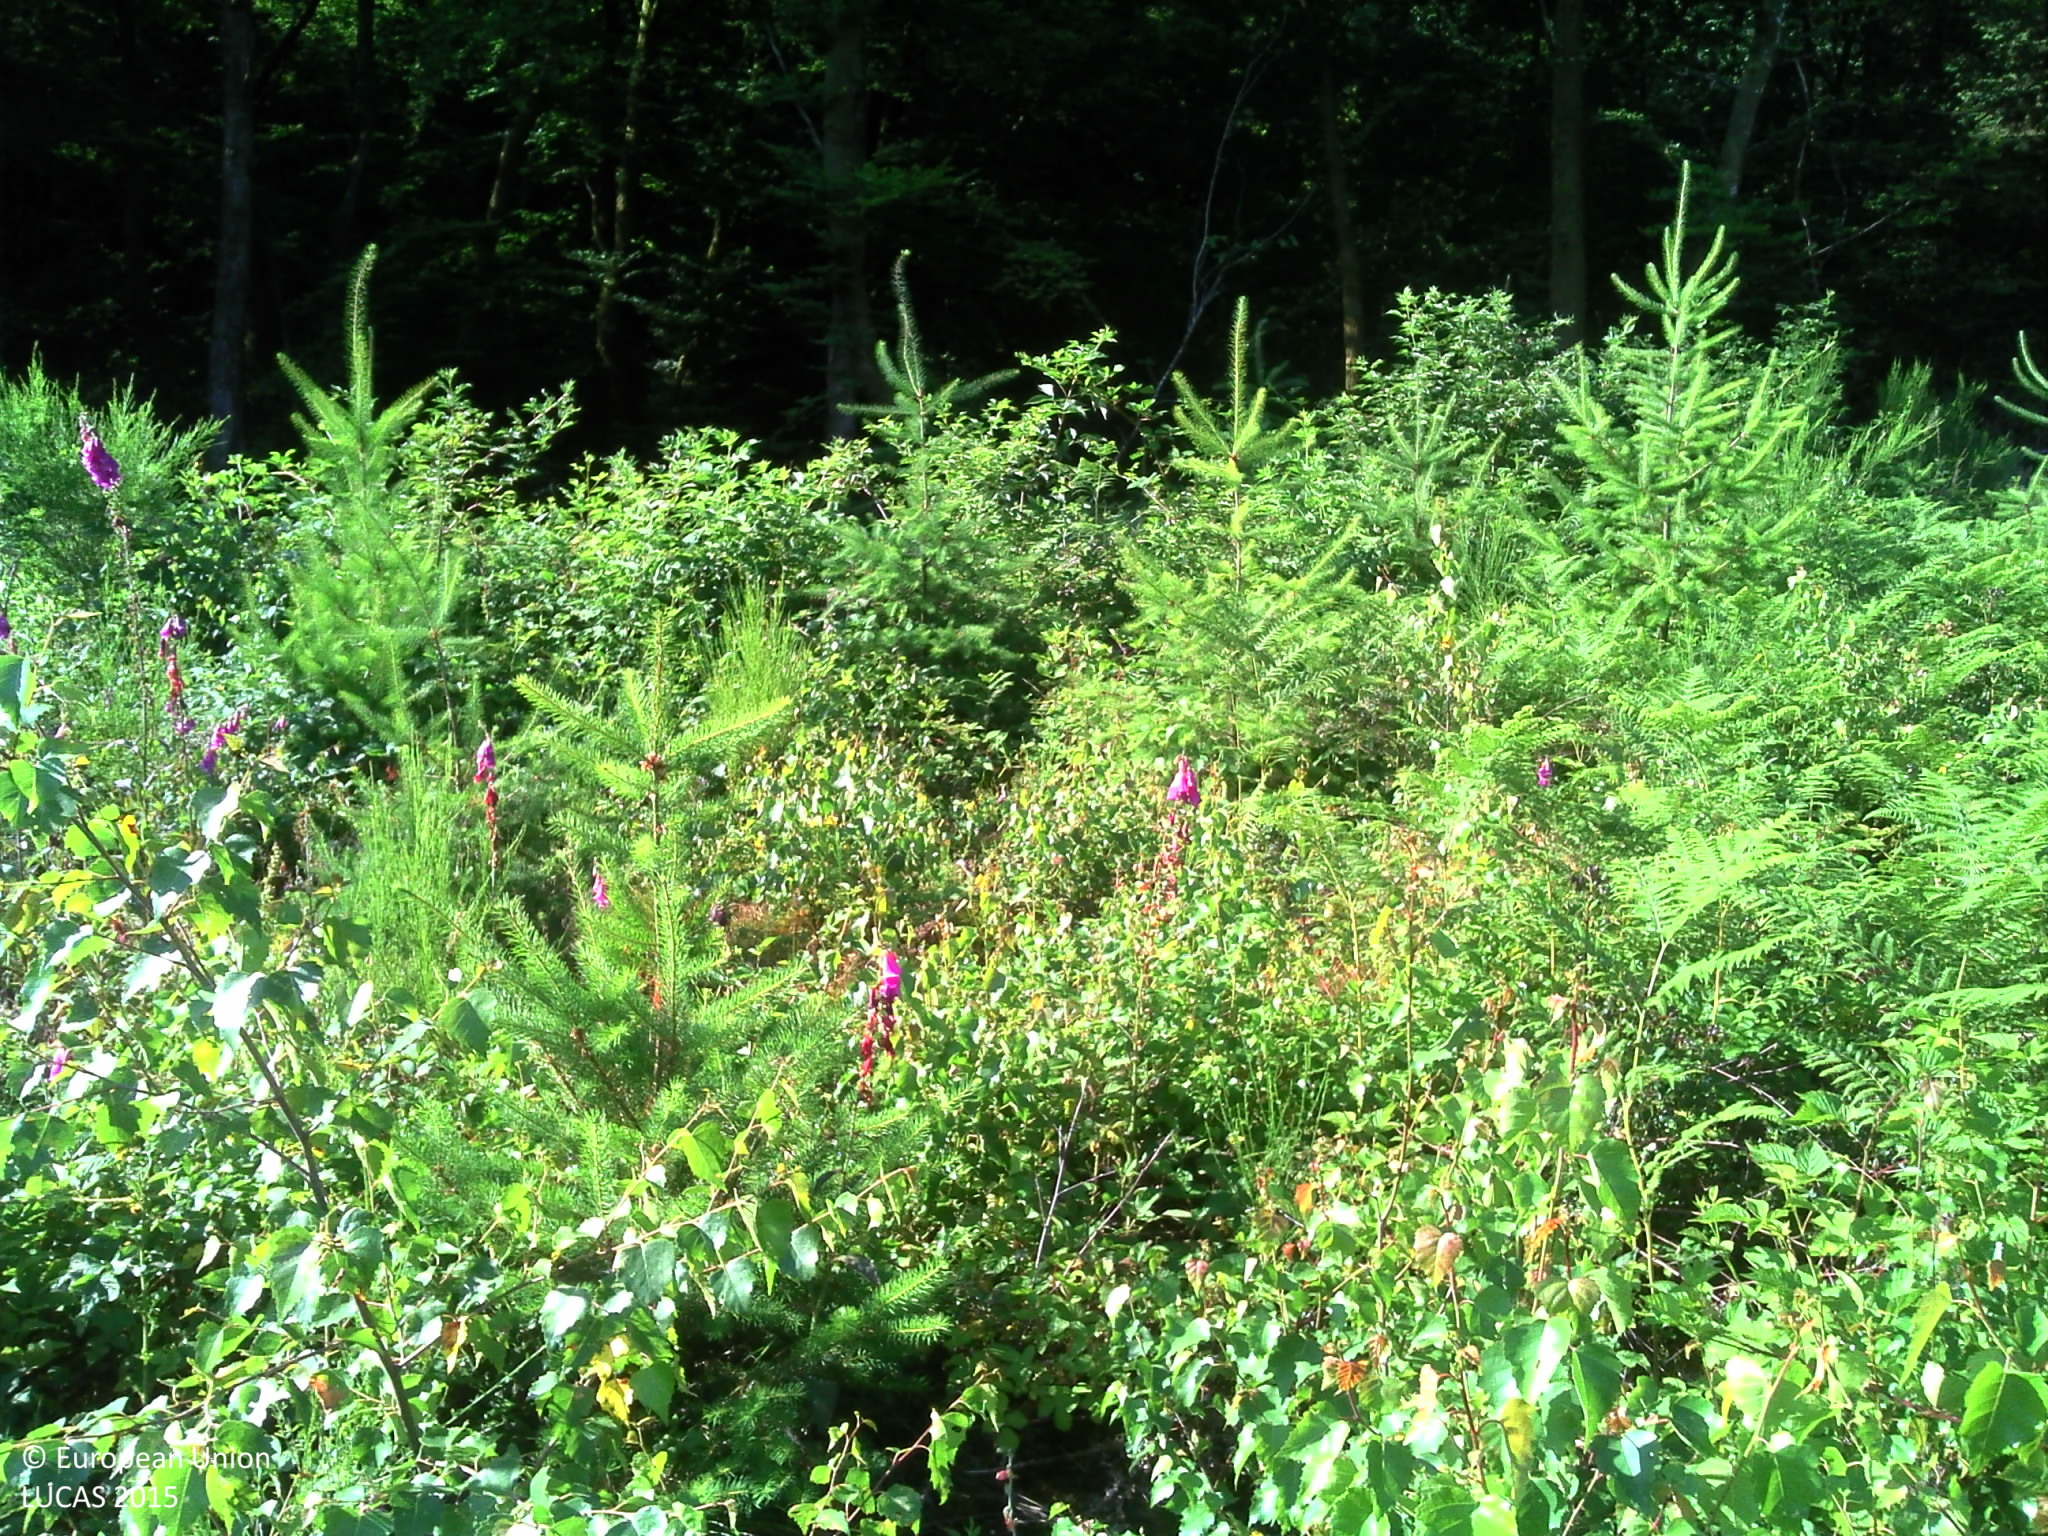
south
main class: Woodland
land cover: Spruce dominated coniferous woodland
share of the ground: 50 - 75 %
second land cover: Spontaneously vegetated surfaces
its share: 25 - 50 %
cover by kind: coniferous forest trees 60 %, broadleaved forest trees 20 %, shrubs 10 %, herbaceous plants 10 %
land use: Forestry
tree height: < 5 m
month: July
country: FR
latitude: 47.1038
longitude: 4.0034
